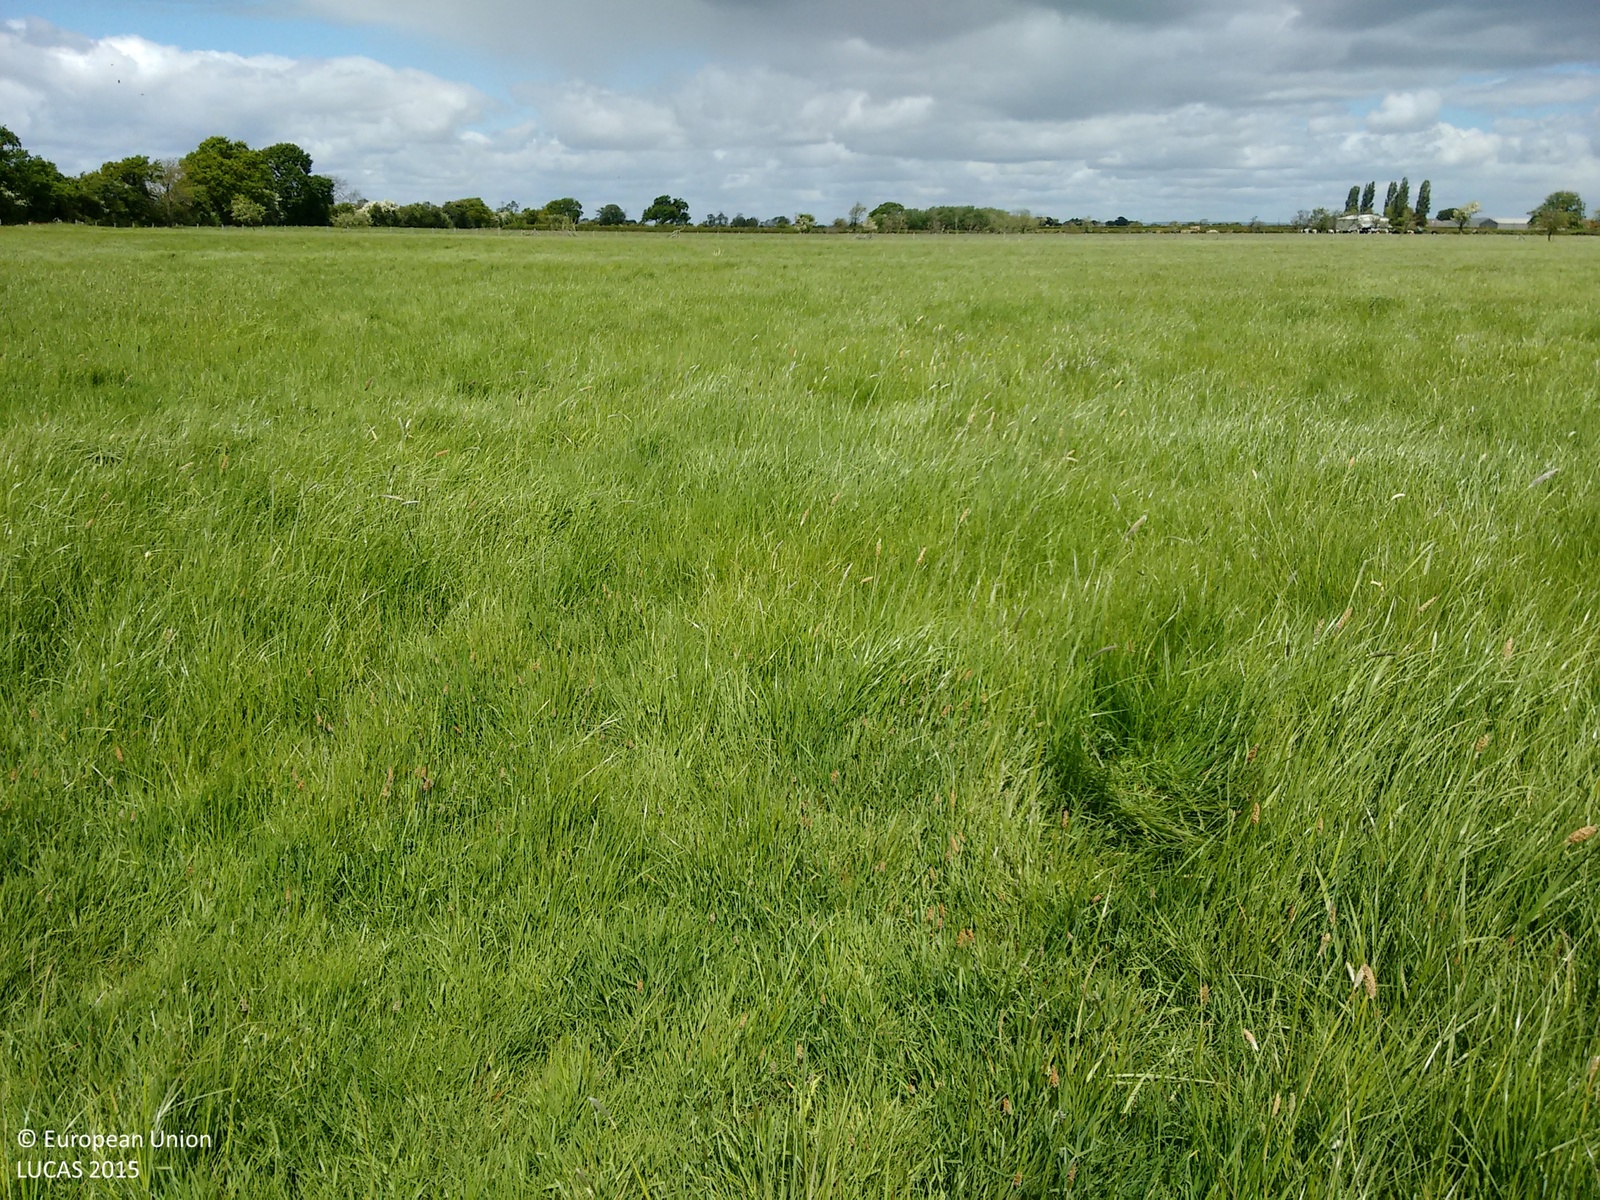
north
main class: Grassland
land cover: Grassland without tree/shrub cover
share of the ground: > 75 %
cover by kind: herbaceous plants 100 %
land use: Agriculture (excluding fallow land and kitchen gardens)
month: May
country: GB
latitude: 53.9683
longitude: -1.2195
